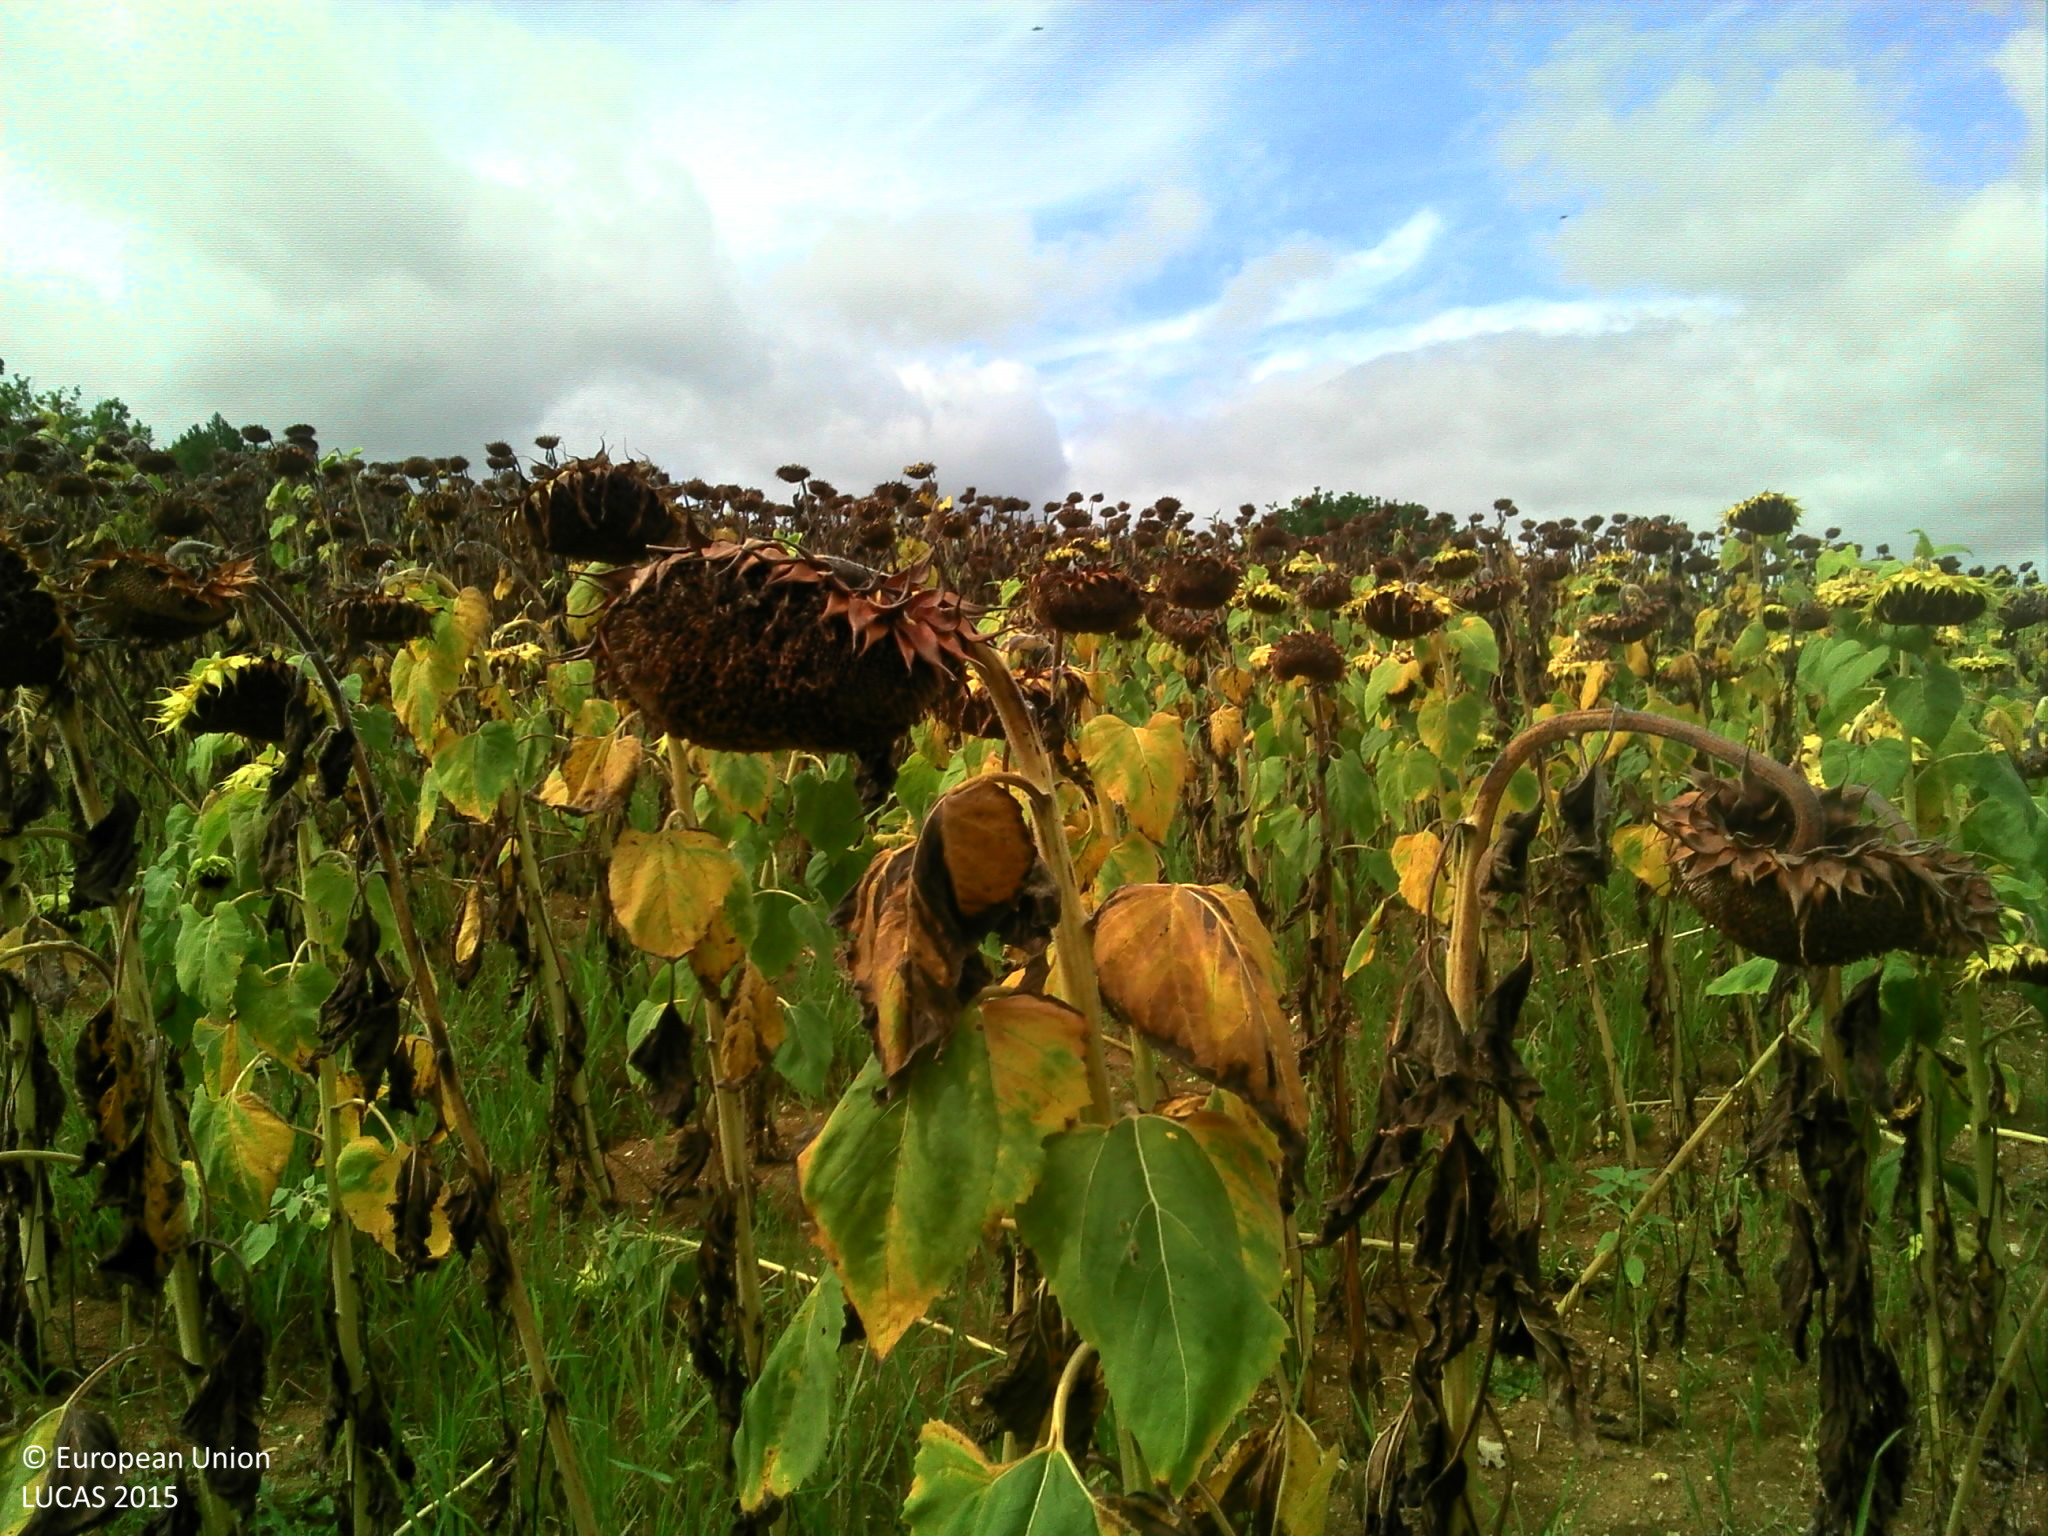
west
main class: Cropland
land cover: Sunflower
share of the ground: > 75 %
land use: Agriculture (excluding fallow land and kitchen gardens)
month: August
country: FR
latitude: 44.3118
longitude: 1.3102
